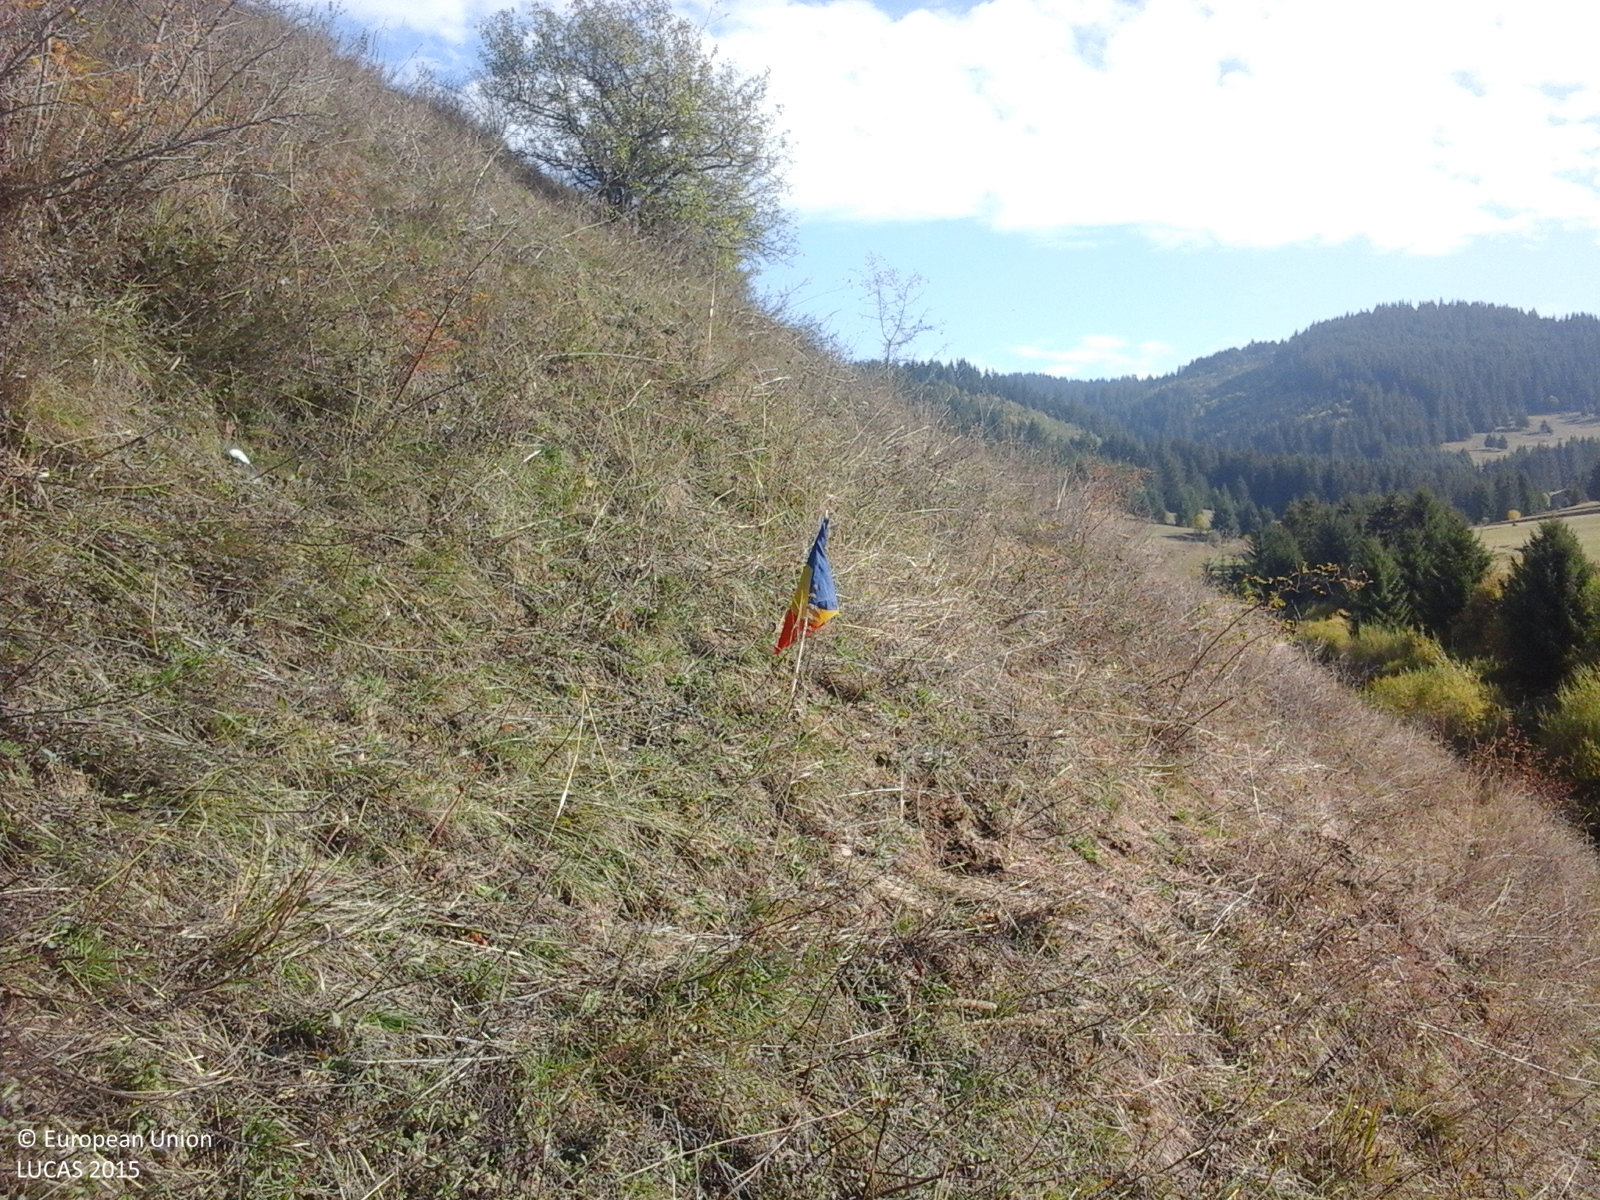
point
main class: Grassland
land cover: Spontaneously vegetated surfaces
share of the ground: > 75 %
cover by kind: herbaceous plants 100 %
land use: Fallow land
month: October
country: RO
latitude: 46.3324
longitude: 25.9806
